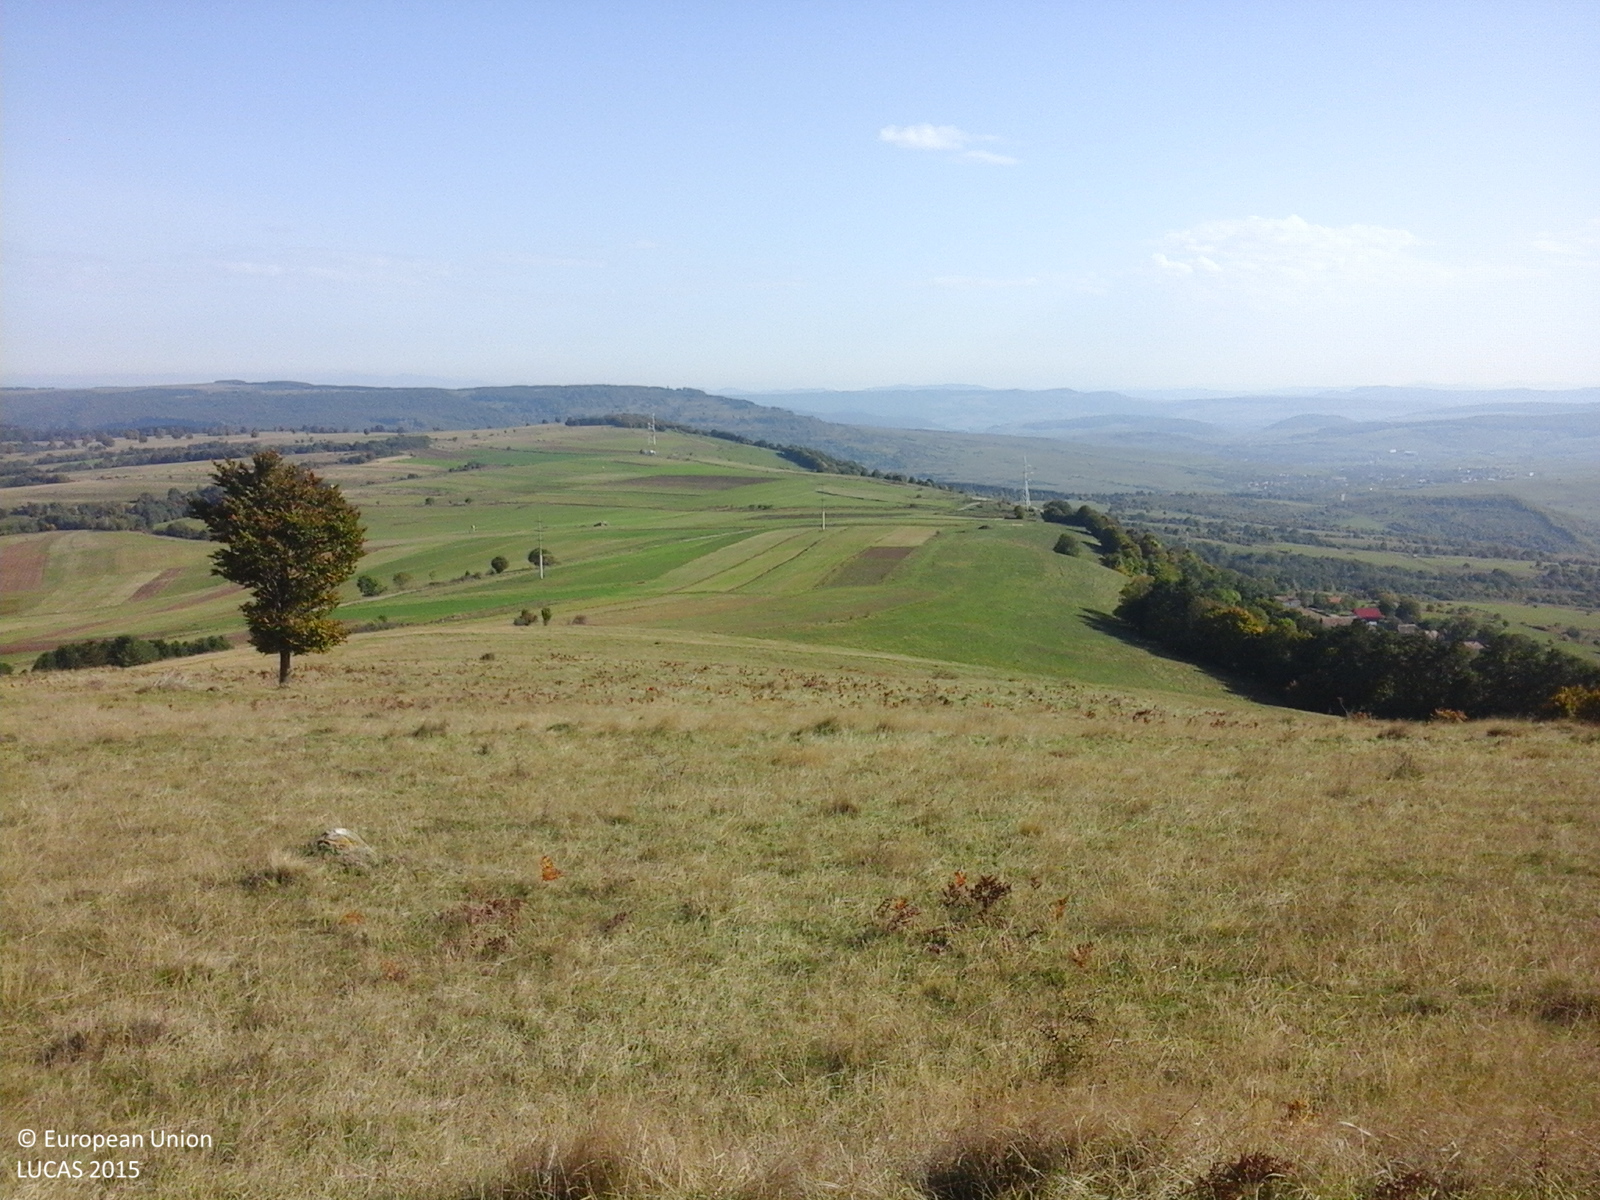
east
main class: Grassland
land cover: Grassland without tree/shrub cover
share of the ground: > 75 %
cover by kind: herbaceous plants 100 %
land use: Agriculture (excluding fallow land and kitchen gardens)
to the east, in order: Grassland without tree/shrub cover
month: October
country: RO
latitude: 46.4314
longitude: 25.1841
